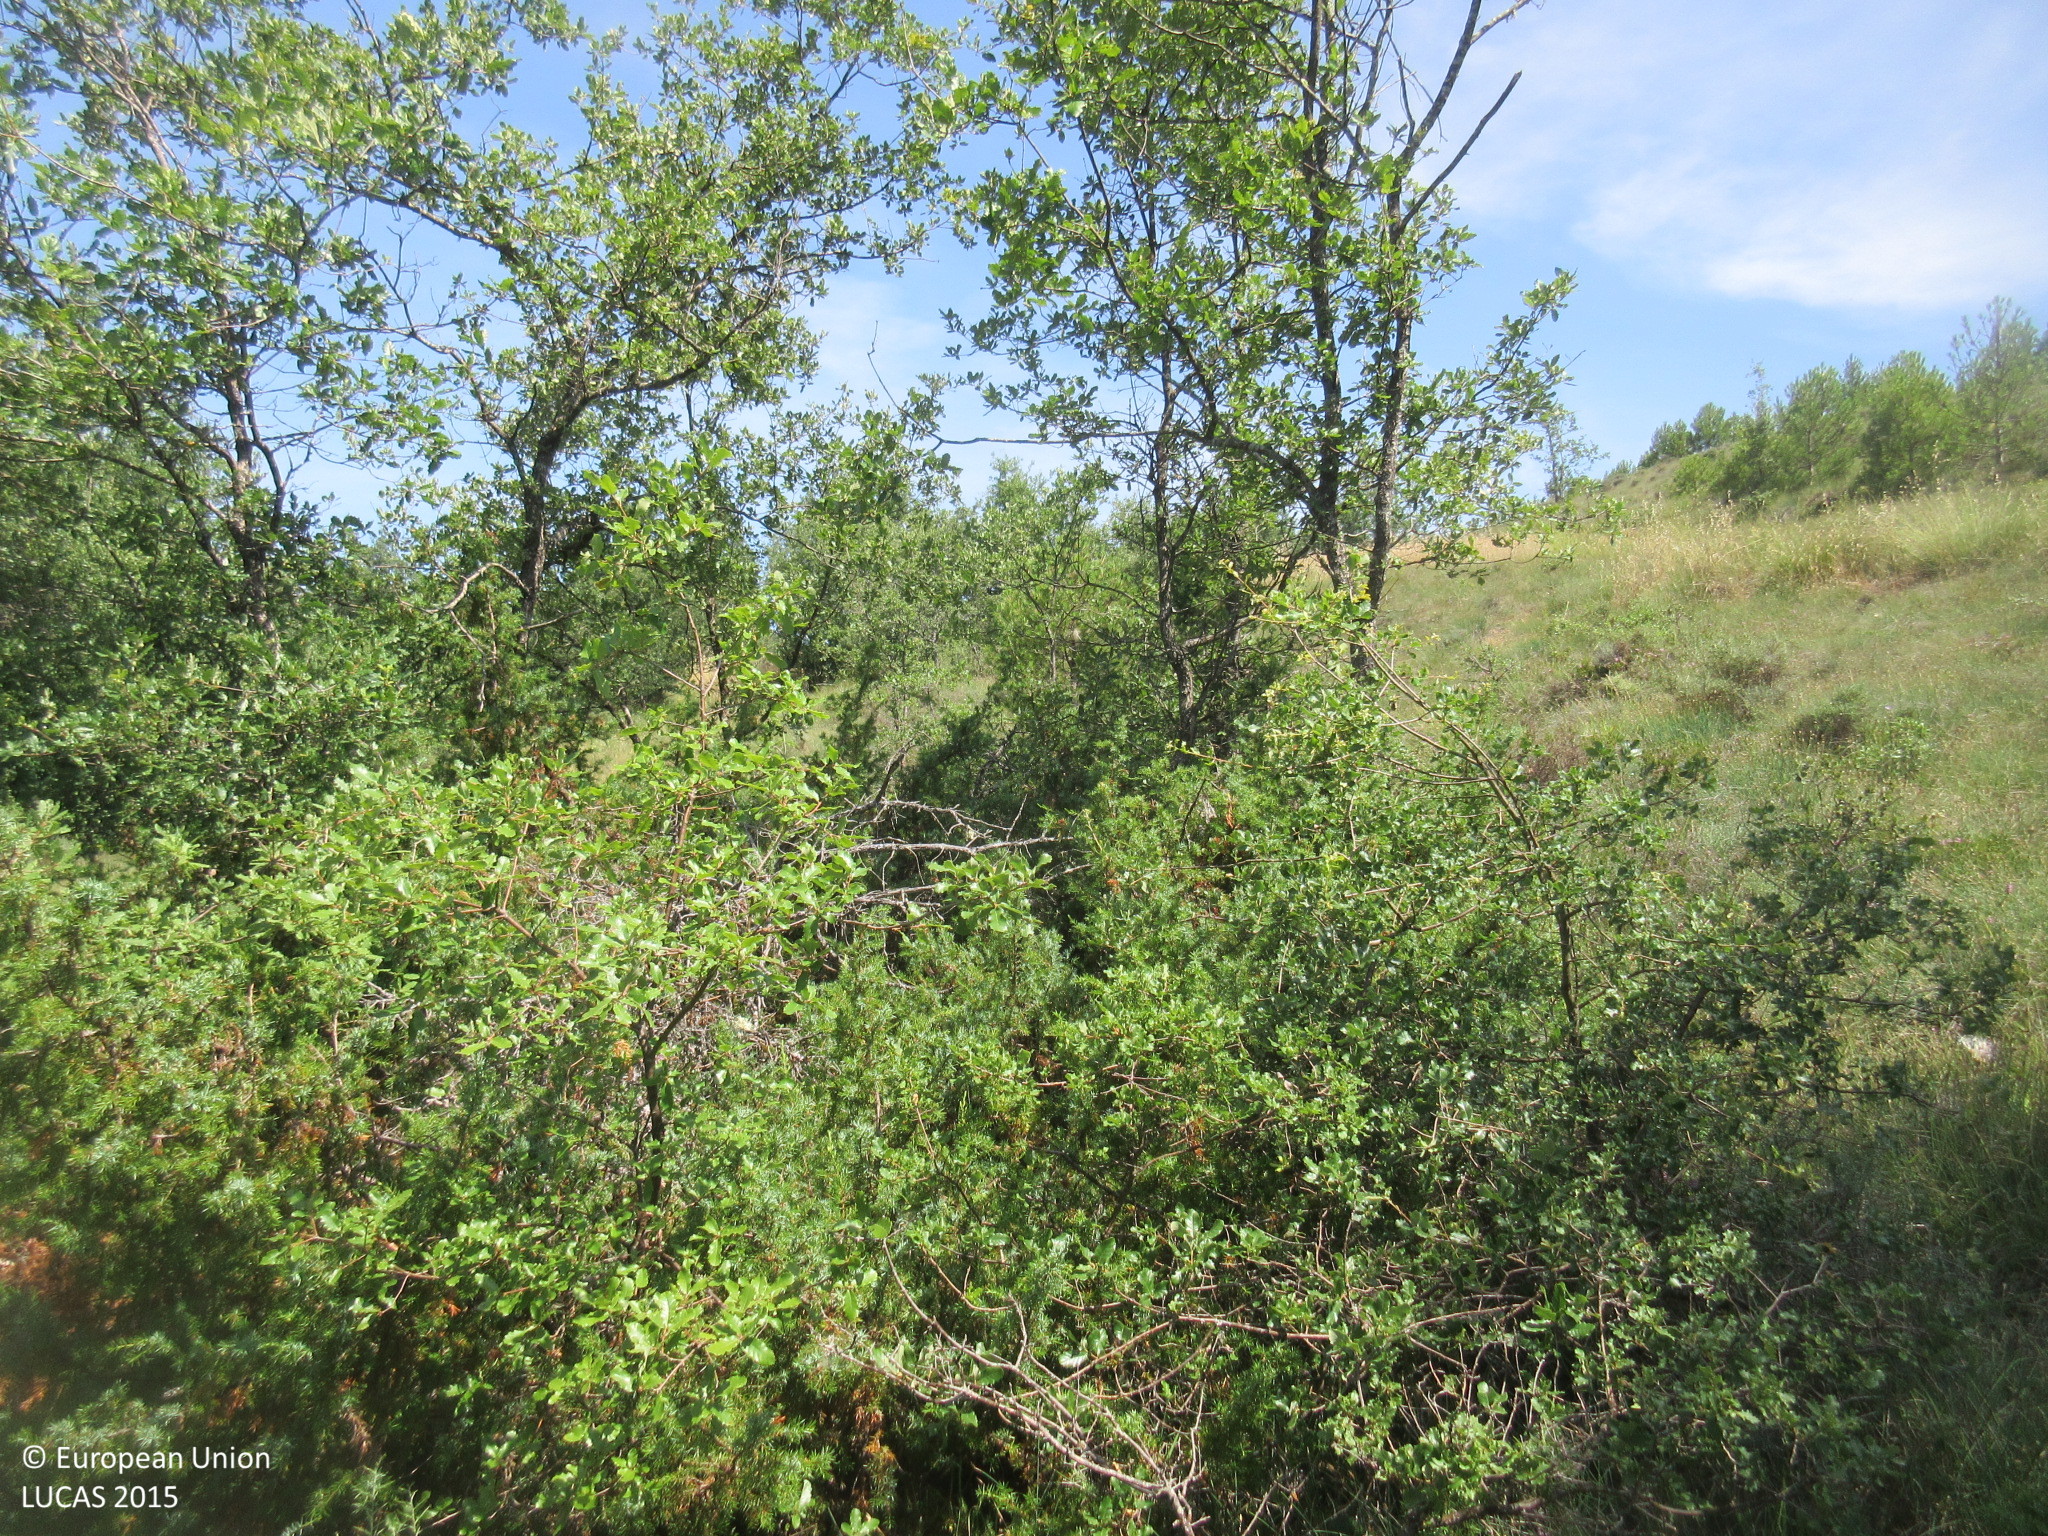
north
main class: Woodland
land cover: Broadleaved woodland
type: broadleaved evergreen forest
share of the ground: 50 - 75 %
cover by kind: broadleaved forest trees 70 %, shrubs 15 %, herbaceous plants 15 %
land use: Semi-natural and natural areas not in use
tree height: < 5 m
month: July
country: ES
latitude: 42.9475
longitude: -3.5341
